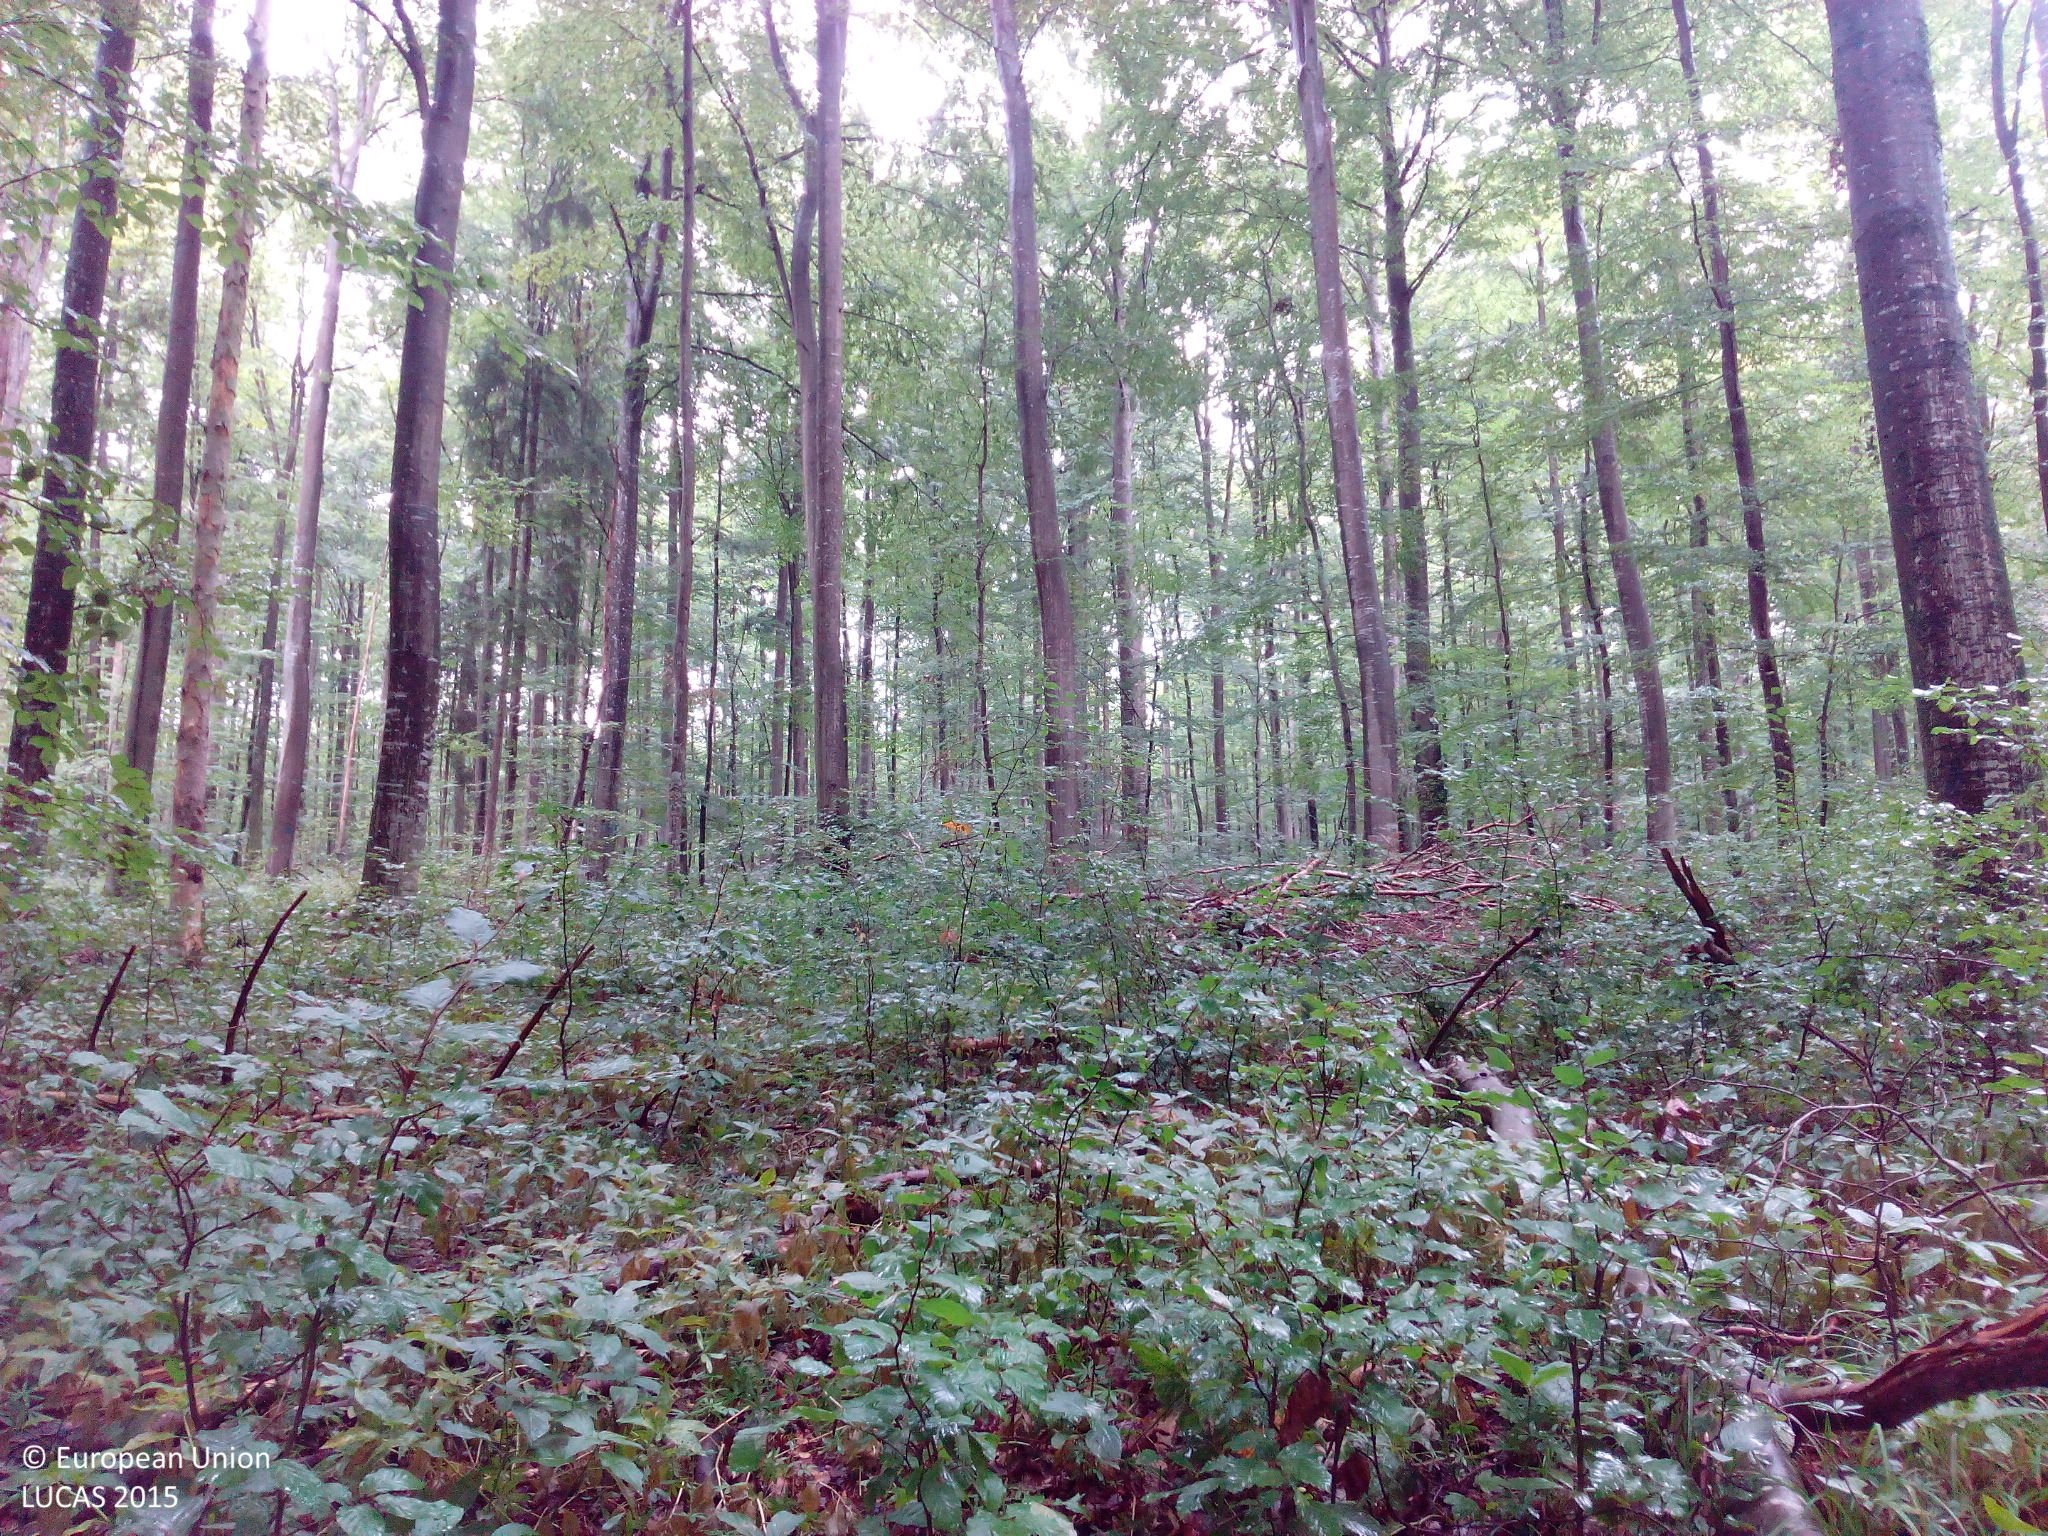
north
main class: Woodland
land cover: Broadleaved woodland
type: mesophytic deciduous forest
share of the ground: > 75 %
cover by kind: broadleaved forest trees 70 %, coniferous forest trees 15 %, shrubs 10 %, unconsolidated bare surface 5 %
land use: Forestry
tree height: > 5 m
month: August
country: DE
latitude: 48.5474
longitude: 9.9594
